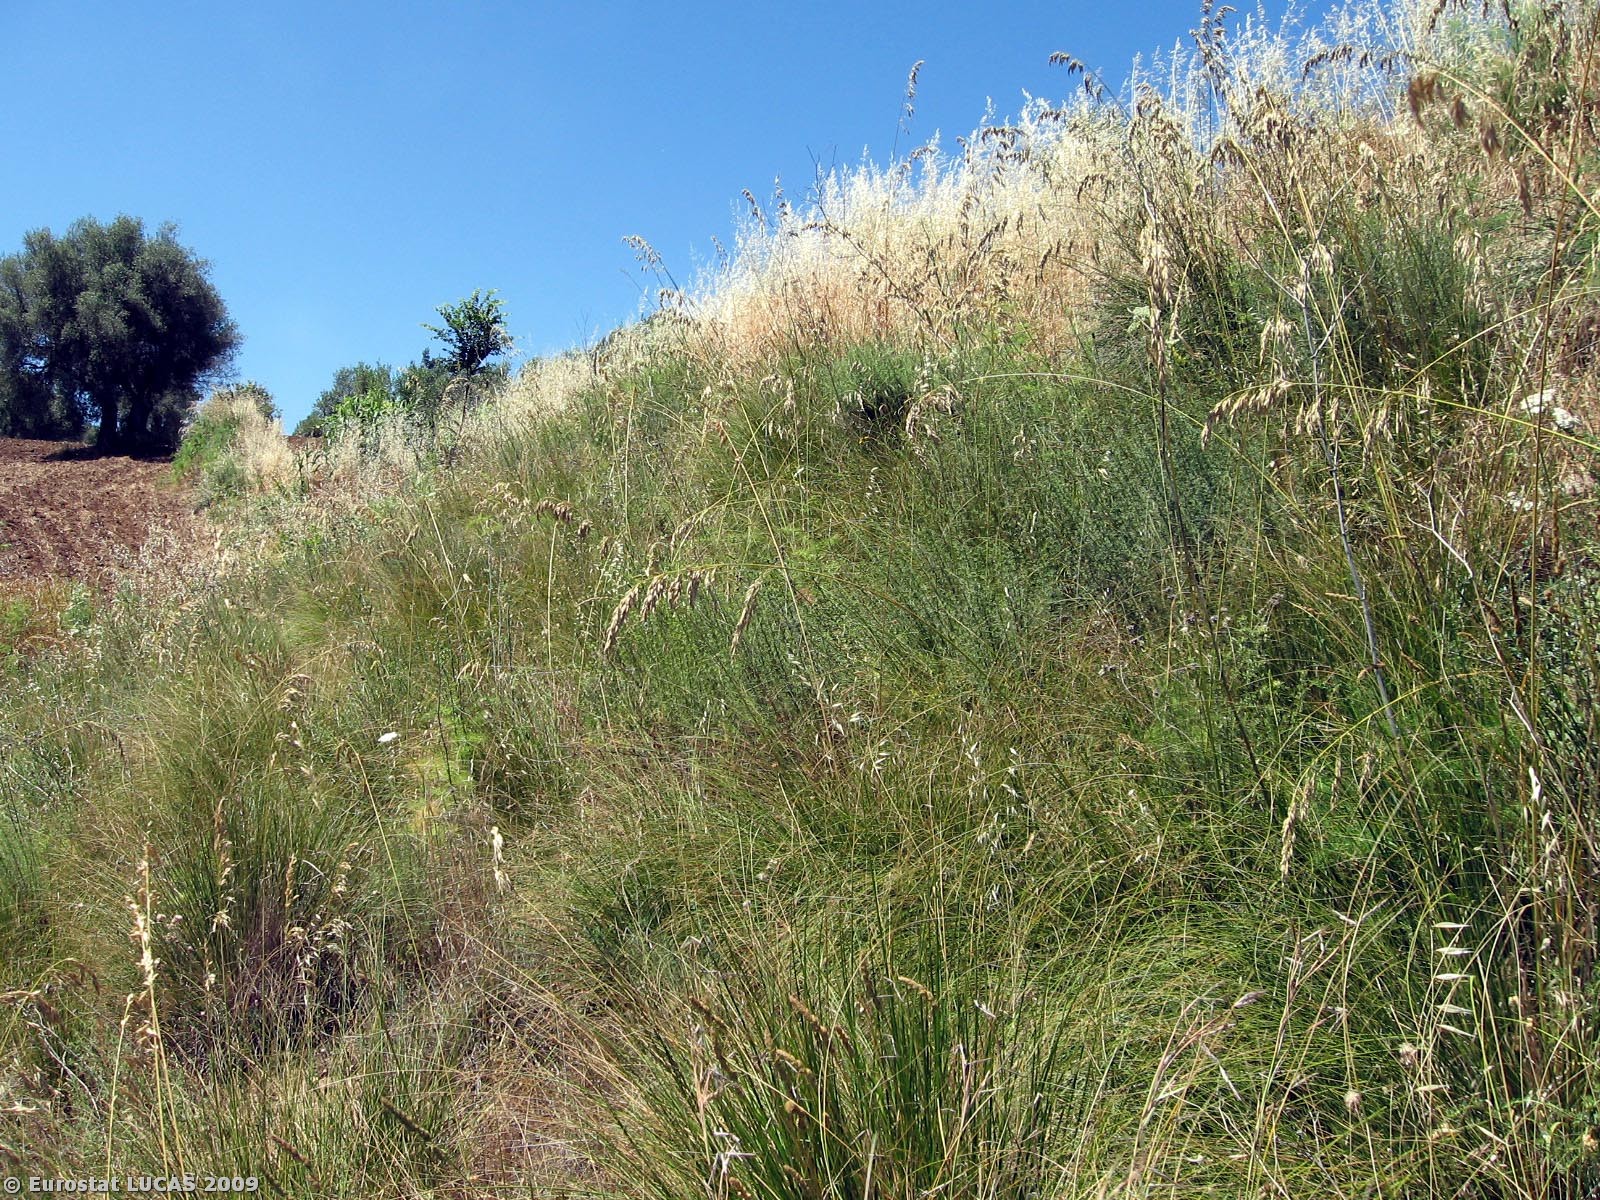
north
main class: Grassland
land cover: Grassland without tree/shrub cover
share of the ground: 50 - 75 %
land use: Unused
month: June
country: IT
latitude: 38.6434
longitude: 16.0895
